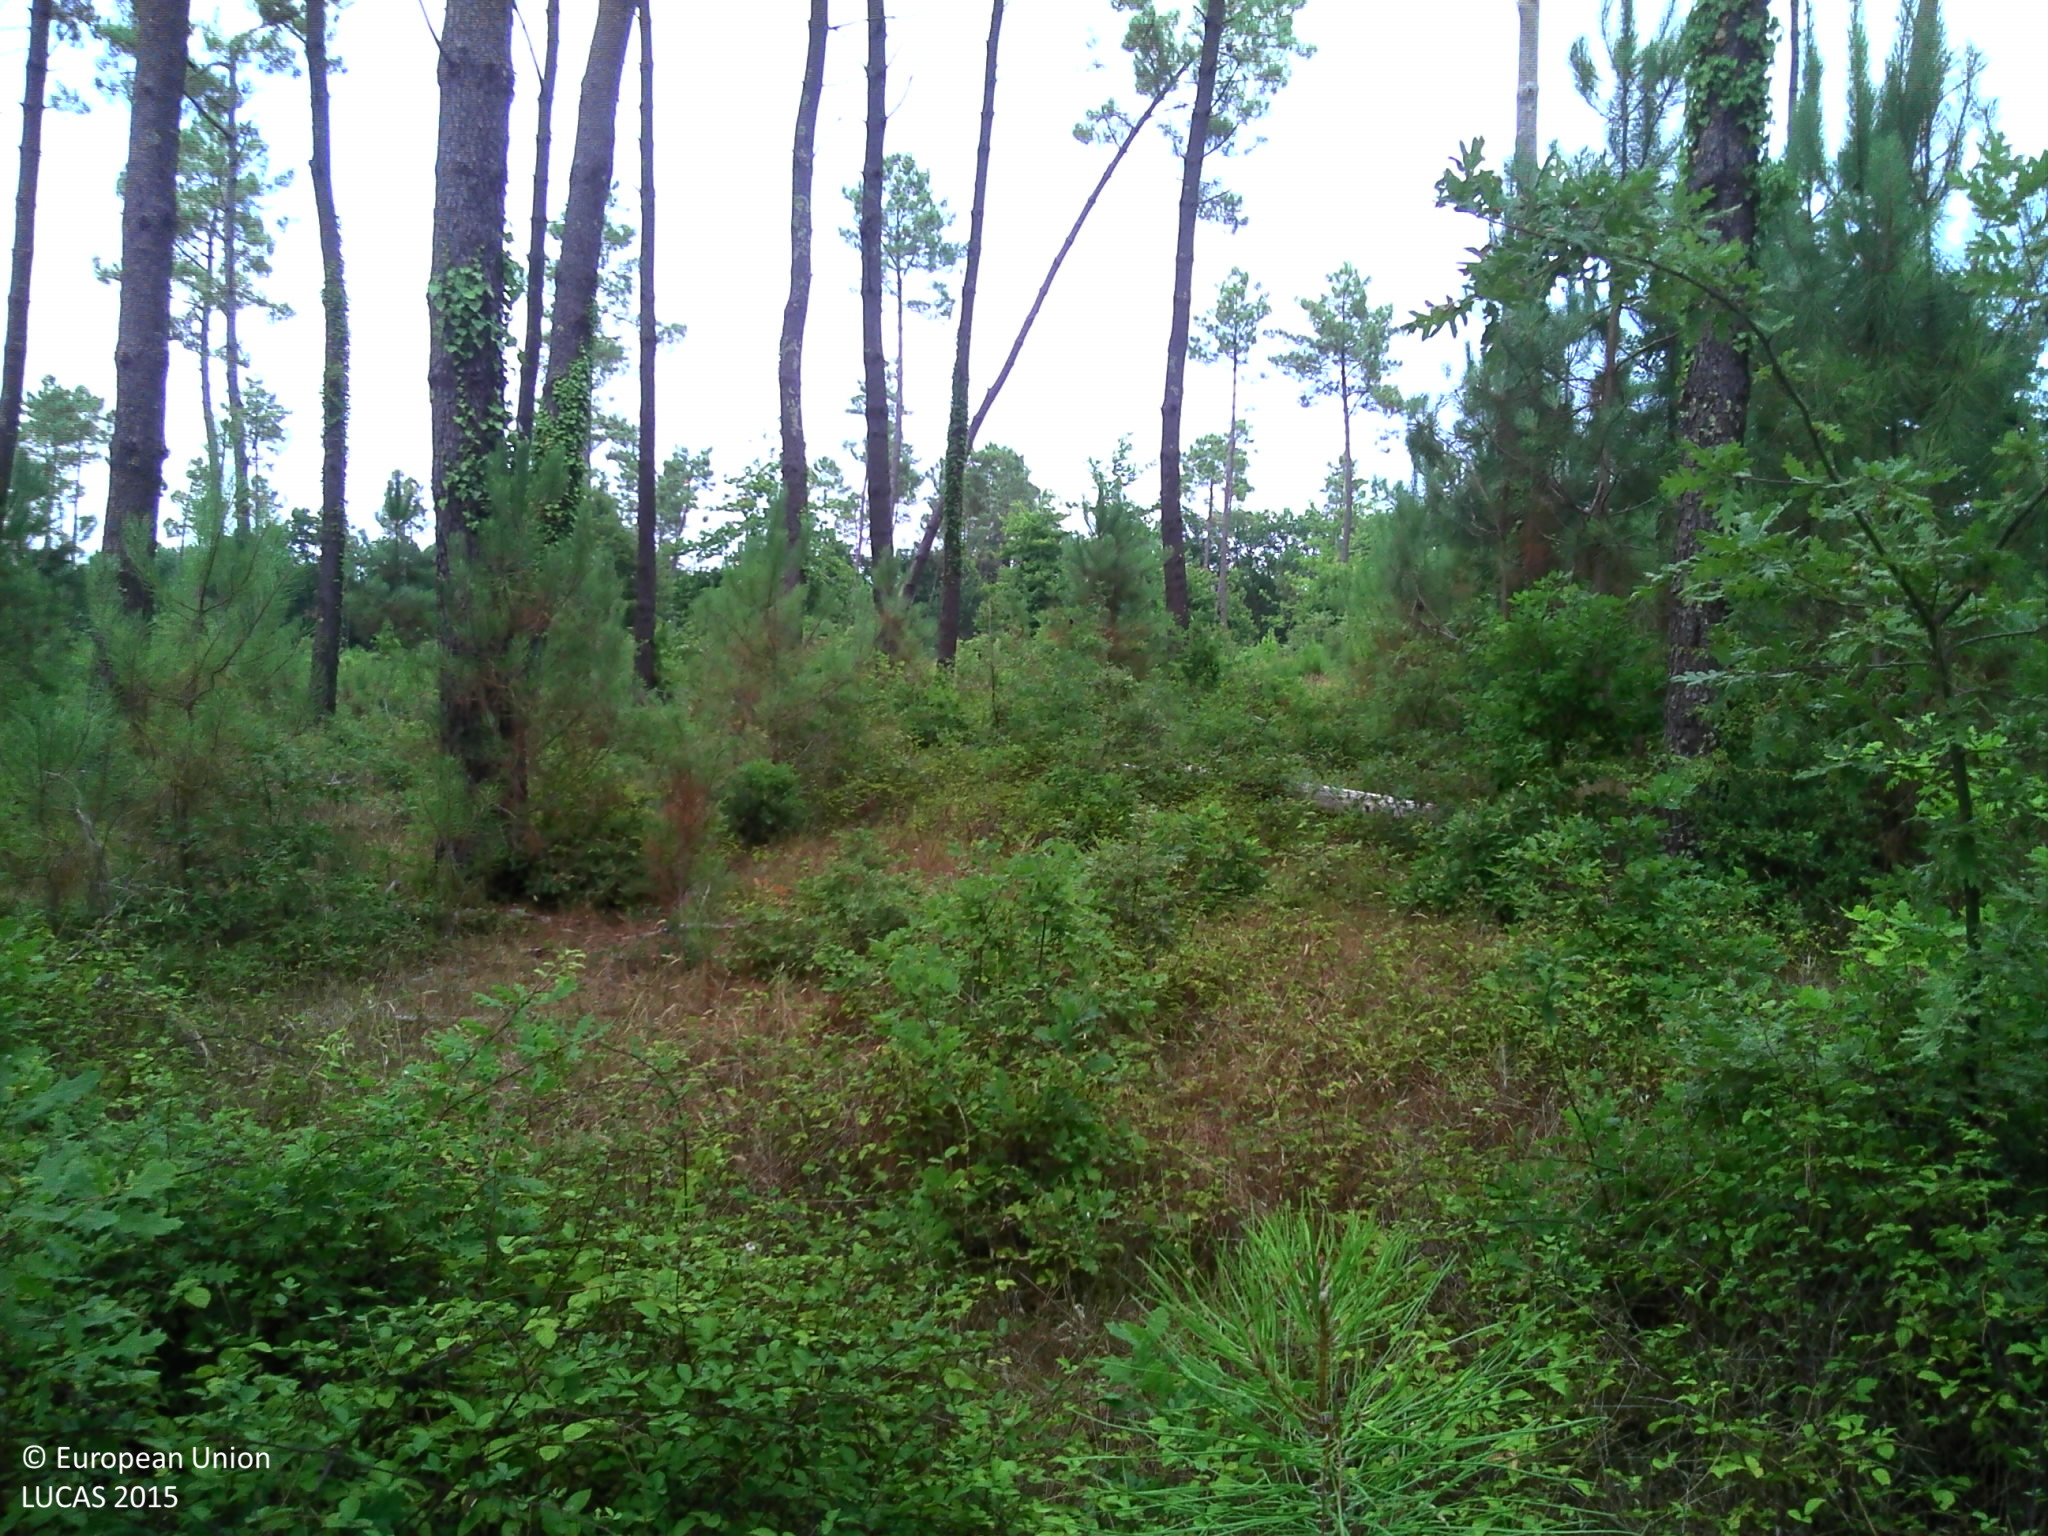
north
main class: Woodland
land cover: Pine dominated coniferous woodland
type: coniferous forest of the mediterranean region
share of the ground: > 75 %
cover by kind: coniferous forest trees 70 %, herbaceous plants 20 %, broadleaved forest trees 5 %, shrubs 5 %
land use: Forestry
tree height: > 5 m
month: August
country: FR
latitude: 44.0660
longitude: -1.0673
